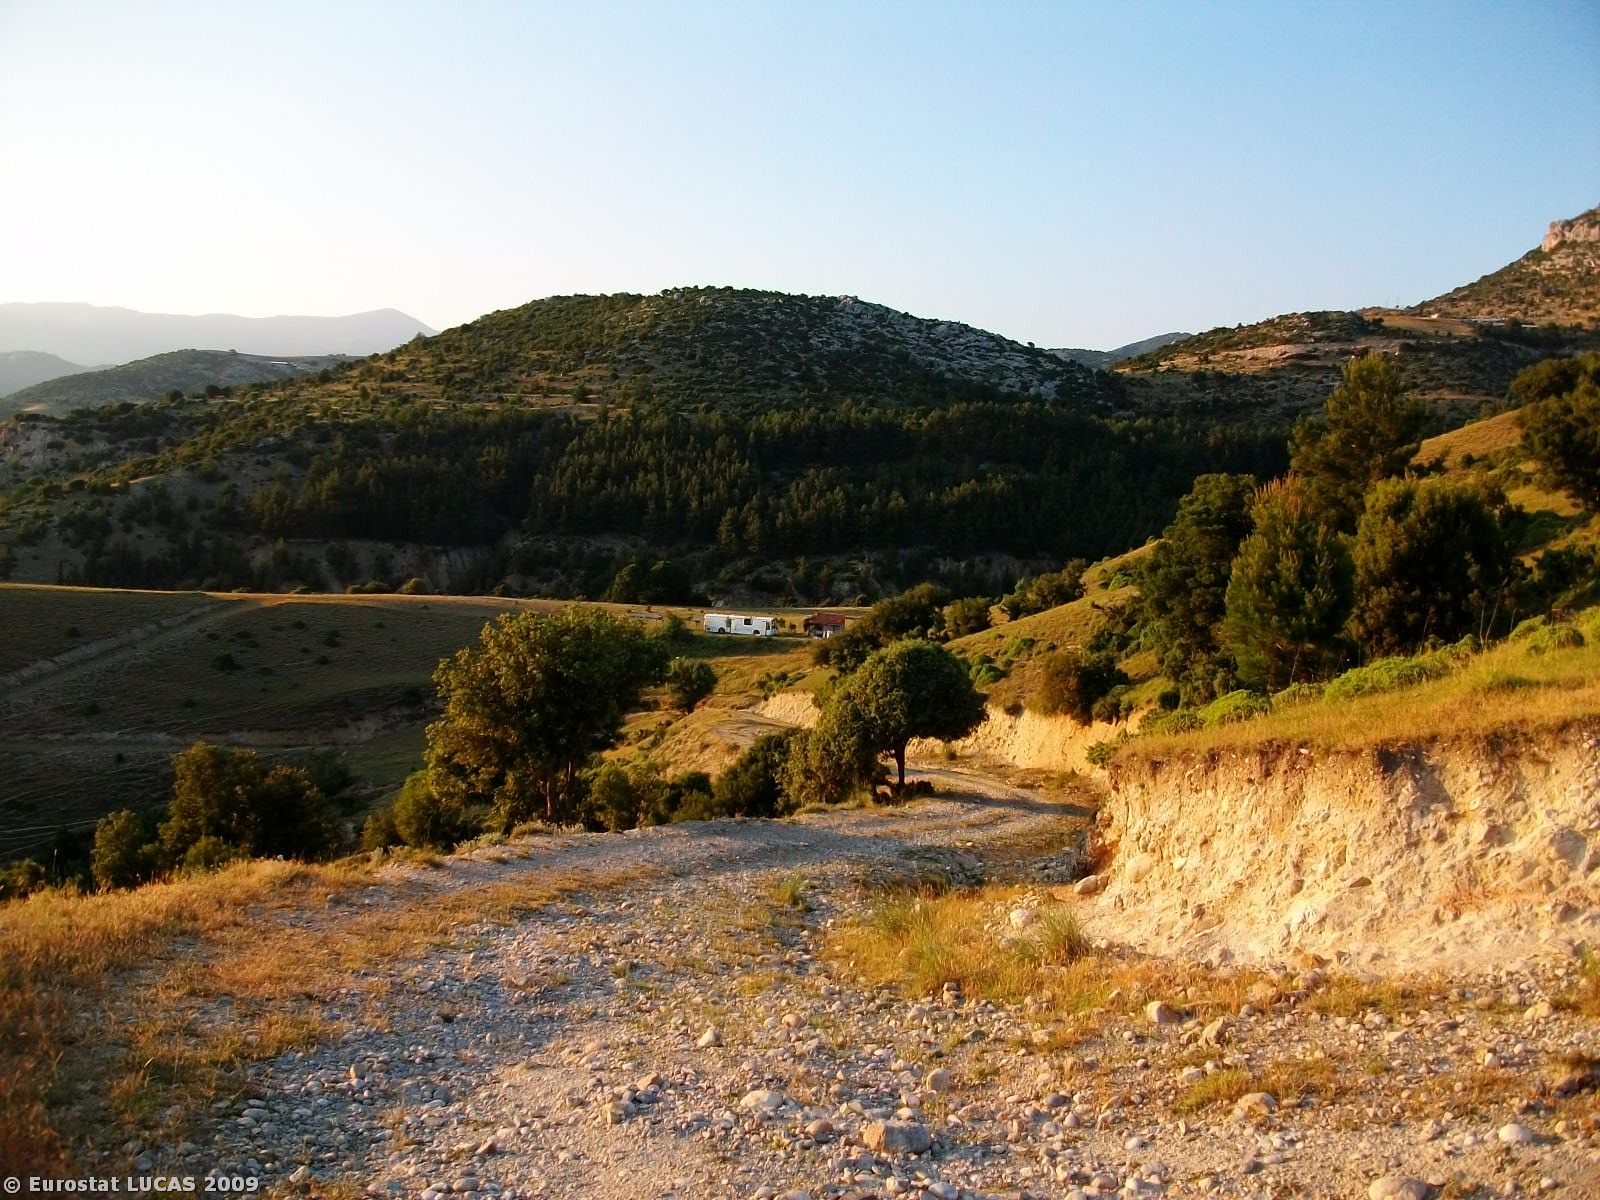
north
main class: Shrubland
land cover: Shrubland with sparse tree cover
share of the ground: > 75 %
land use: Agriculture (excluding fallow land and kitchen gardens)
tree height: > 5 m
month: June
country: GR
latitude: 41.1120
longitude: 23.5848
